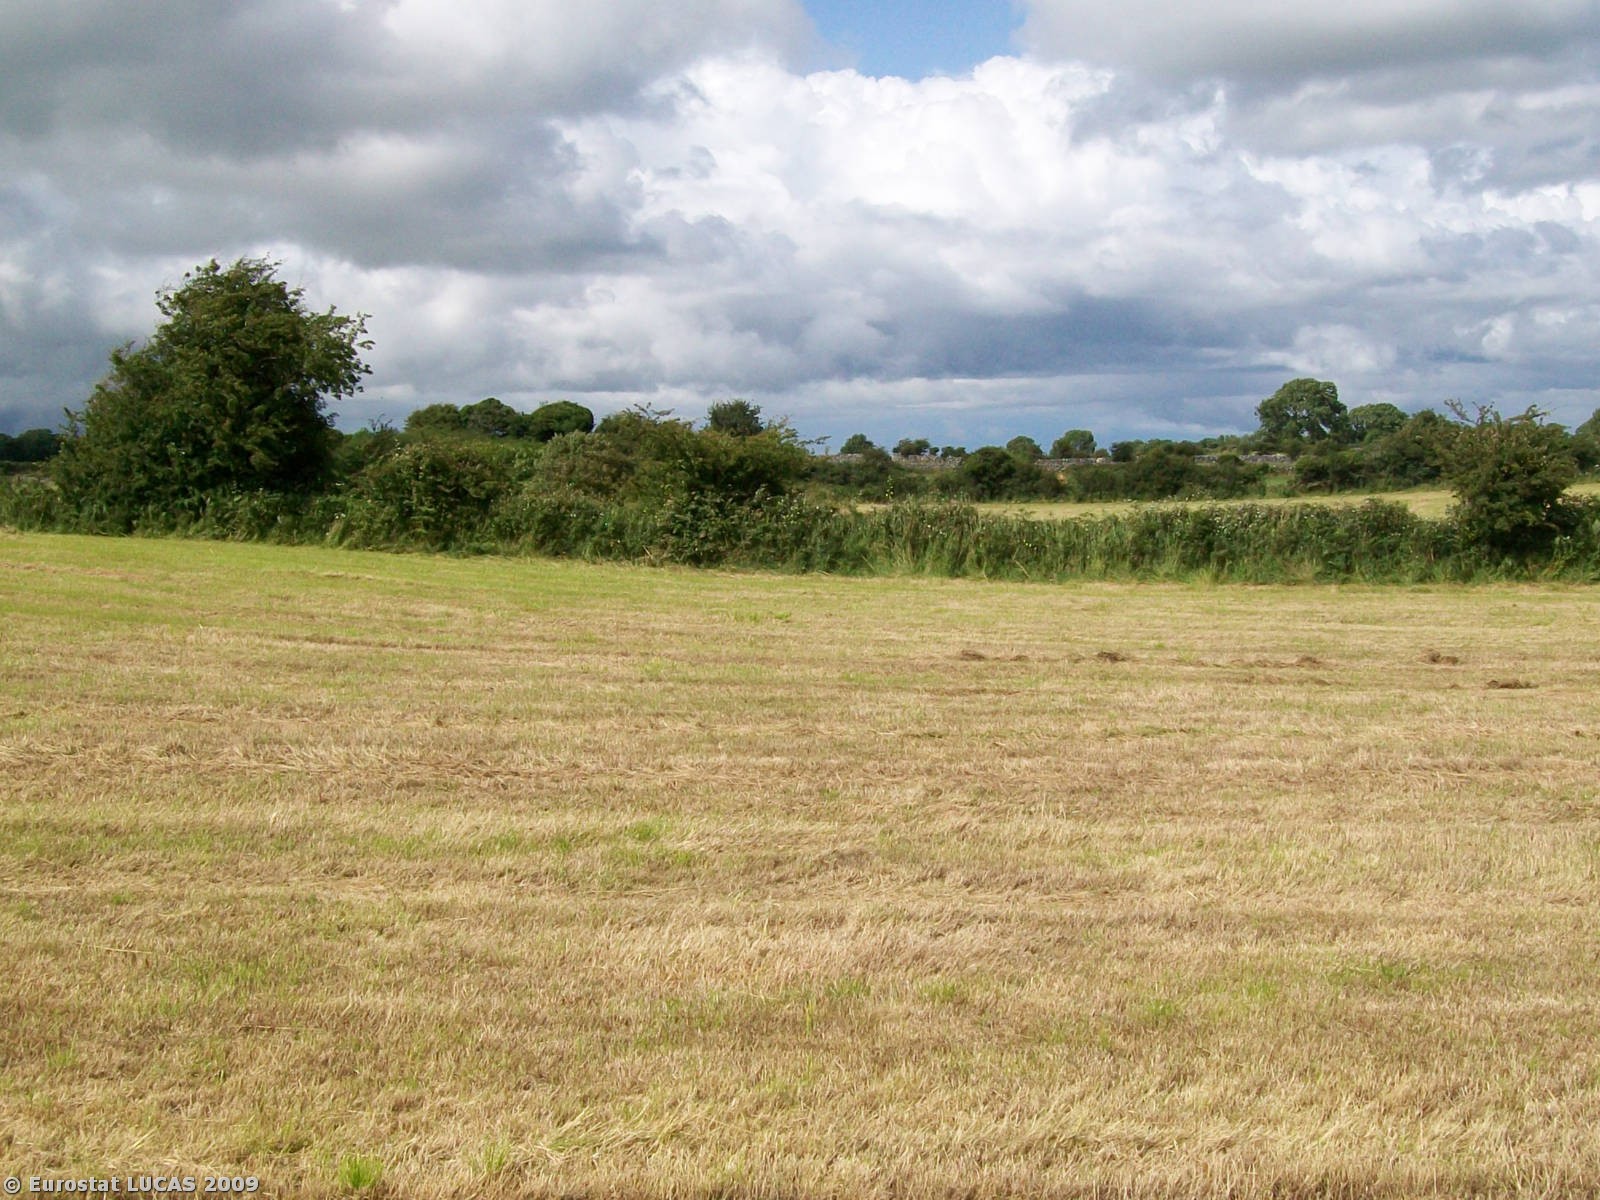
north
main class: Grassland
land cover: Grassland without tree/shrub cover
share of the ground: > 75 %
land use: Agriculture (excluding fallow land and kitchen gardens)
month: July
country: IE
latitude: 53.1938
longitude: -8.7480
